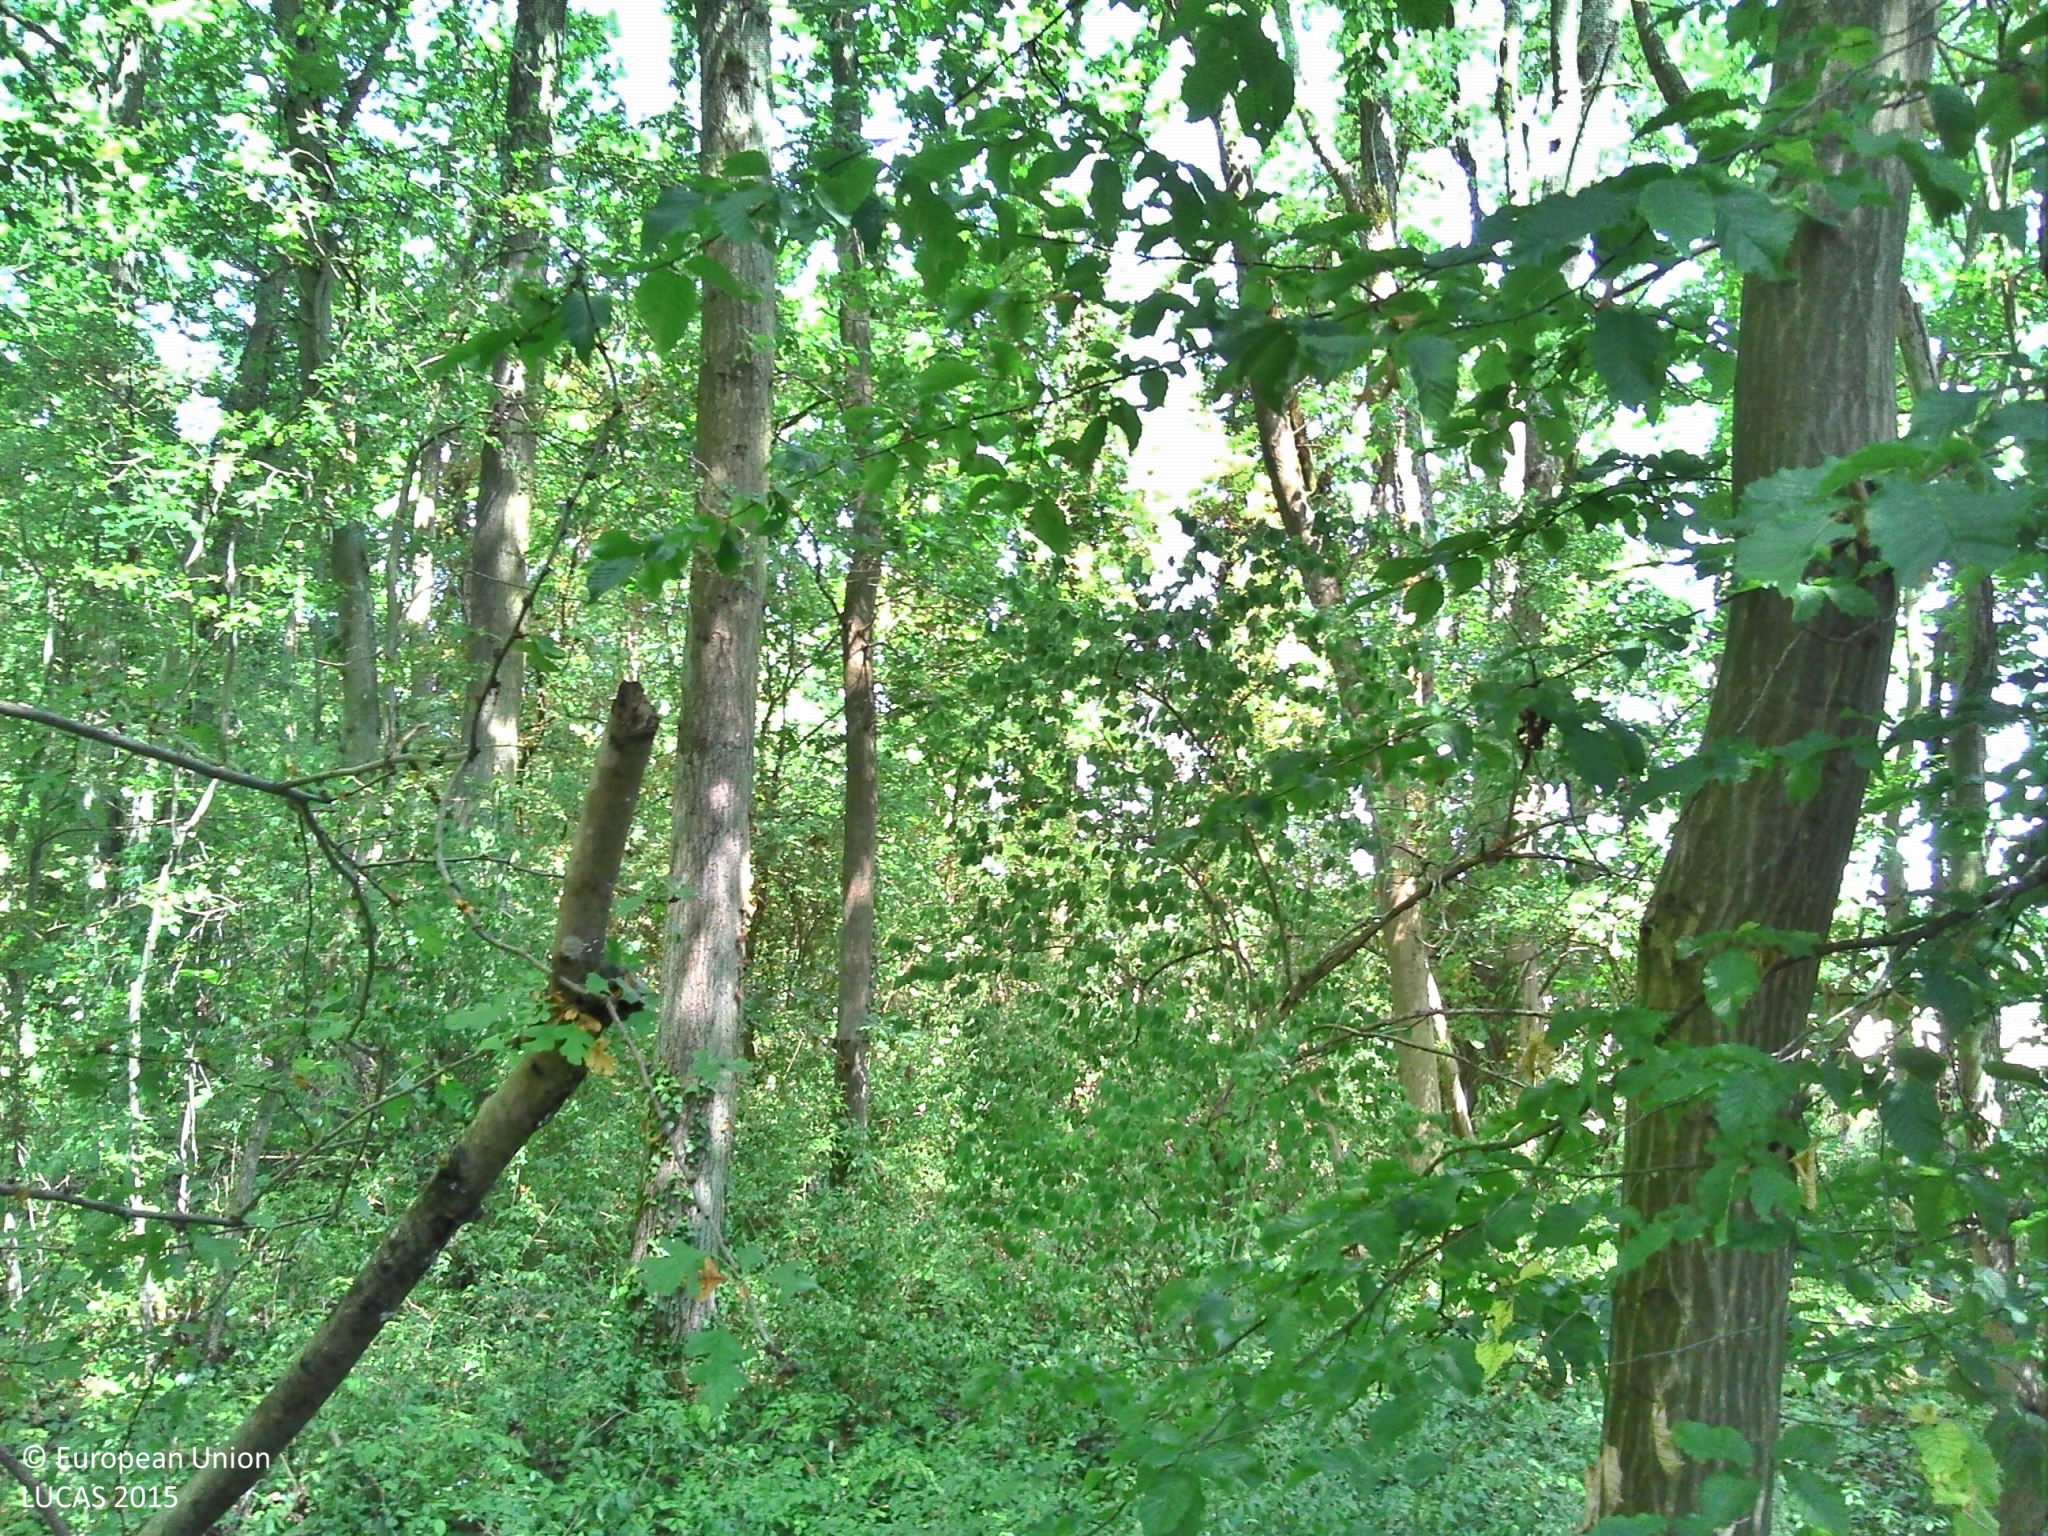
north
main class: Woodland
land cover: Broadleaved woodland
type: mesophytic deciduous forest
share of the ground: > 75 %
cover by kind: broadleaved forest trees 80 %, shrubs 10 %, herbaceous plants 10 %
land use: Forestry
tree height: > 5 m
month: July
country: FR
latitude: 49.2236
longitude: 2.3670
